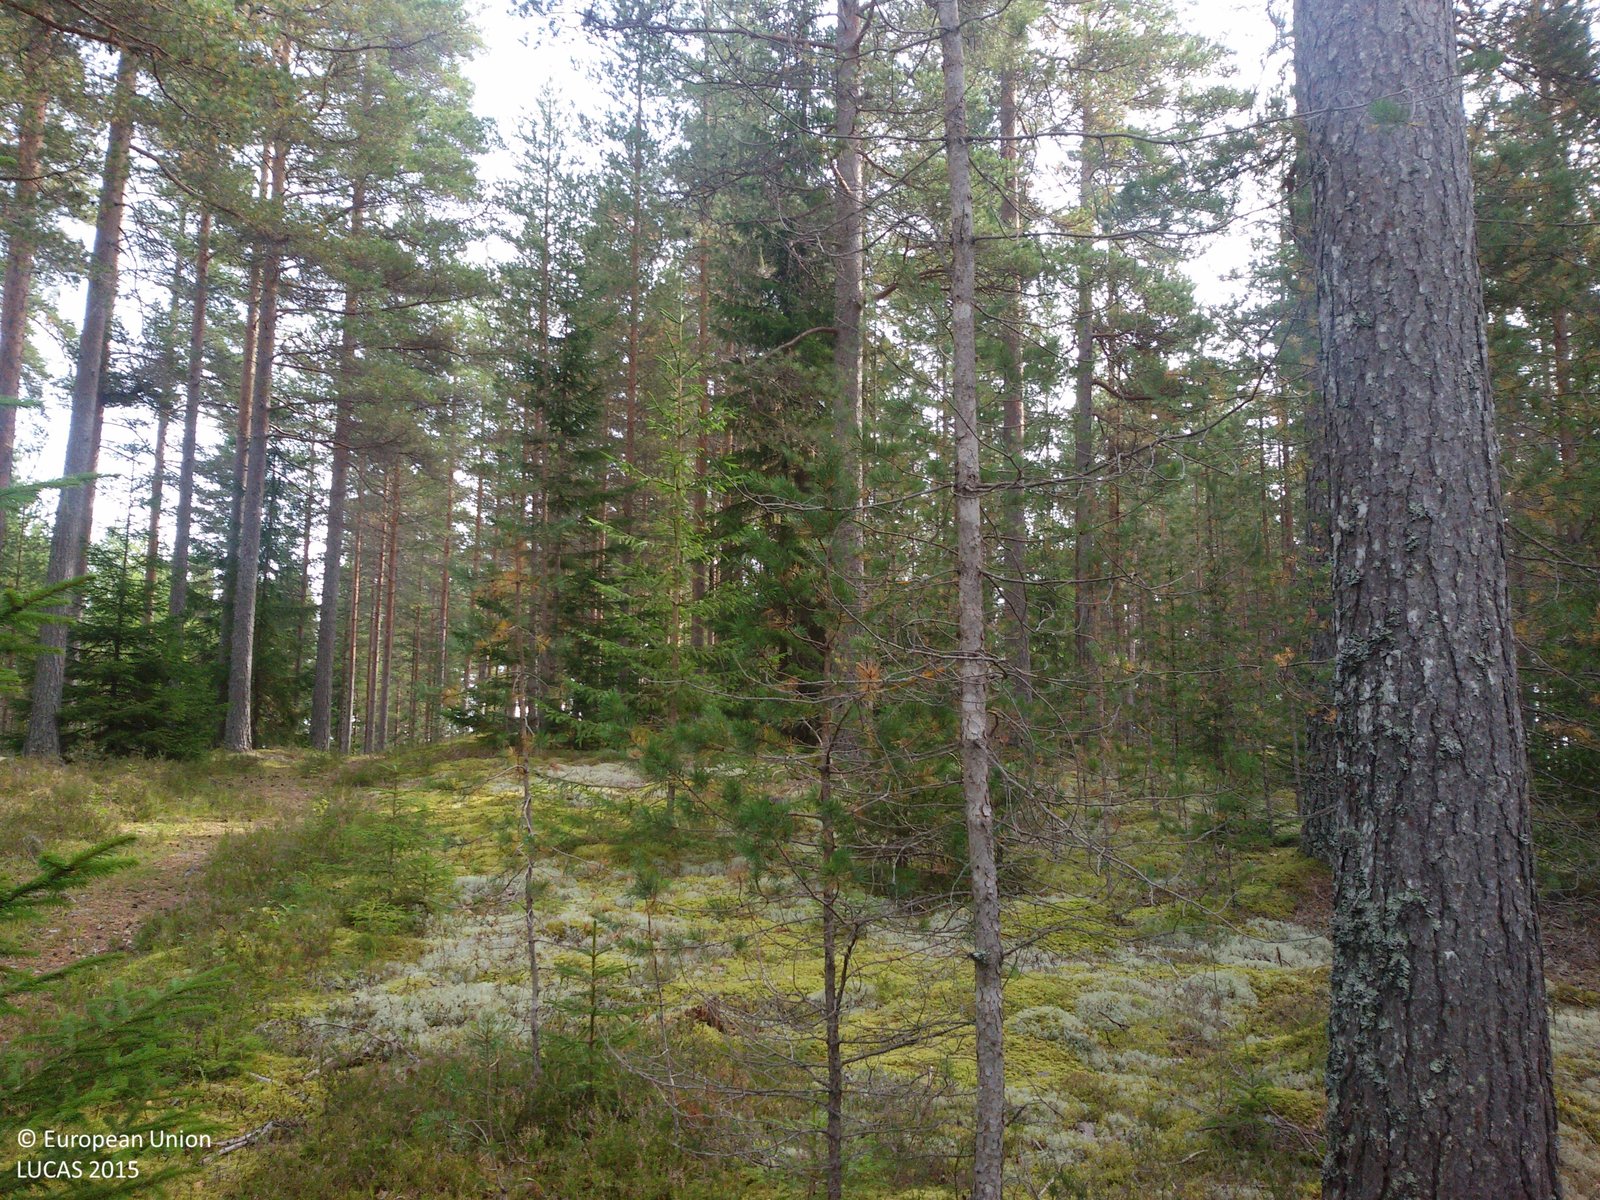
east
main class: Woodland
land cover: Pine dominated coniferous woodland
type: boreal forest
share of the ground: 50 - 75 %
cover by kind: coniferous forest trees 60 %, lichens and mosses 30 %, herbaceous plants 10 %
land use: Forestry
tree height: > 5 m
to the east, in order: Pine dominated coniferous woodland; Tracks; Pine dominated coniferous woodland; Tracks; Pine dominated coniferous woodland; Spruce dominated coniferous woodland
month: September
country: SE
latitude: 60.9853
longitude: 15.2535
